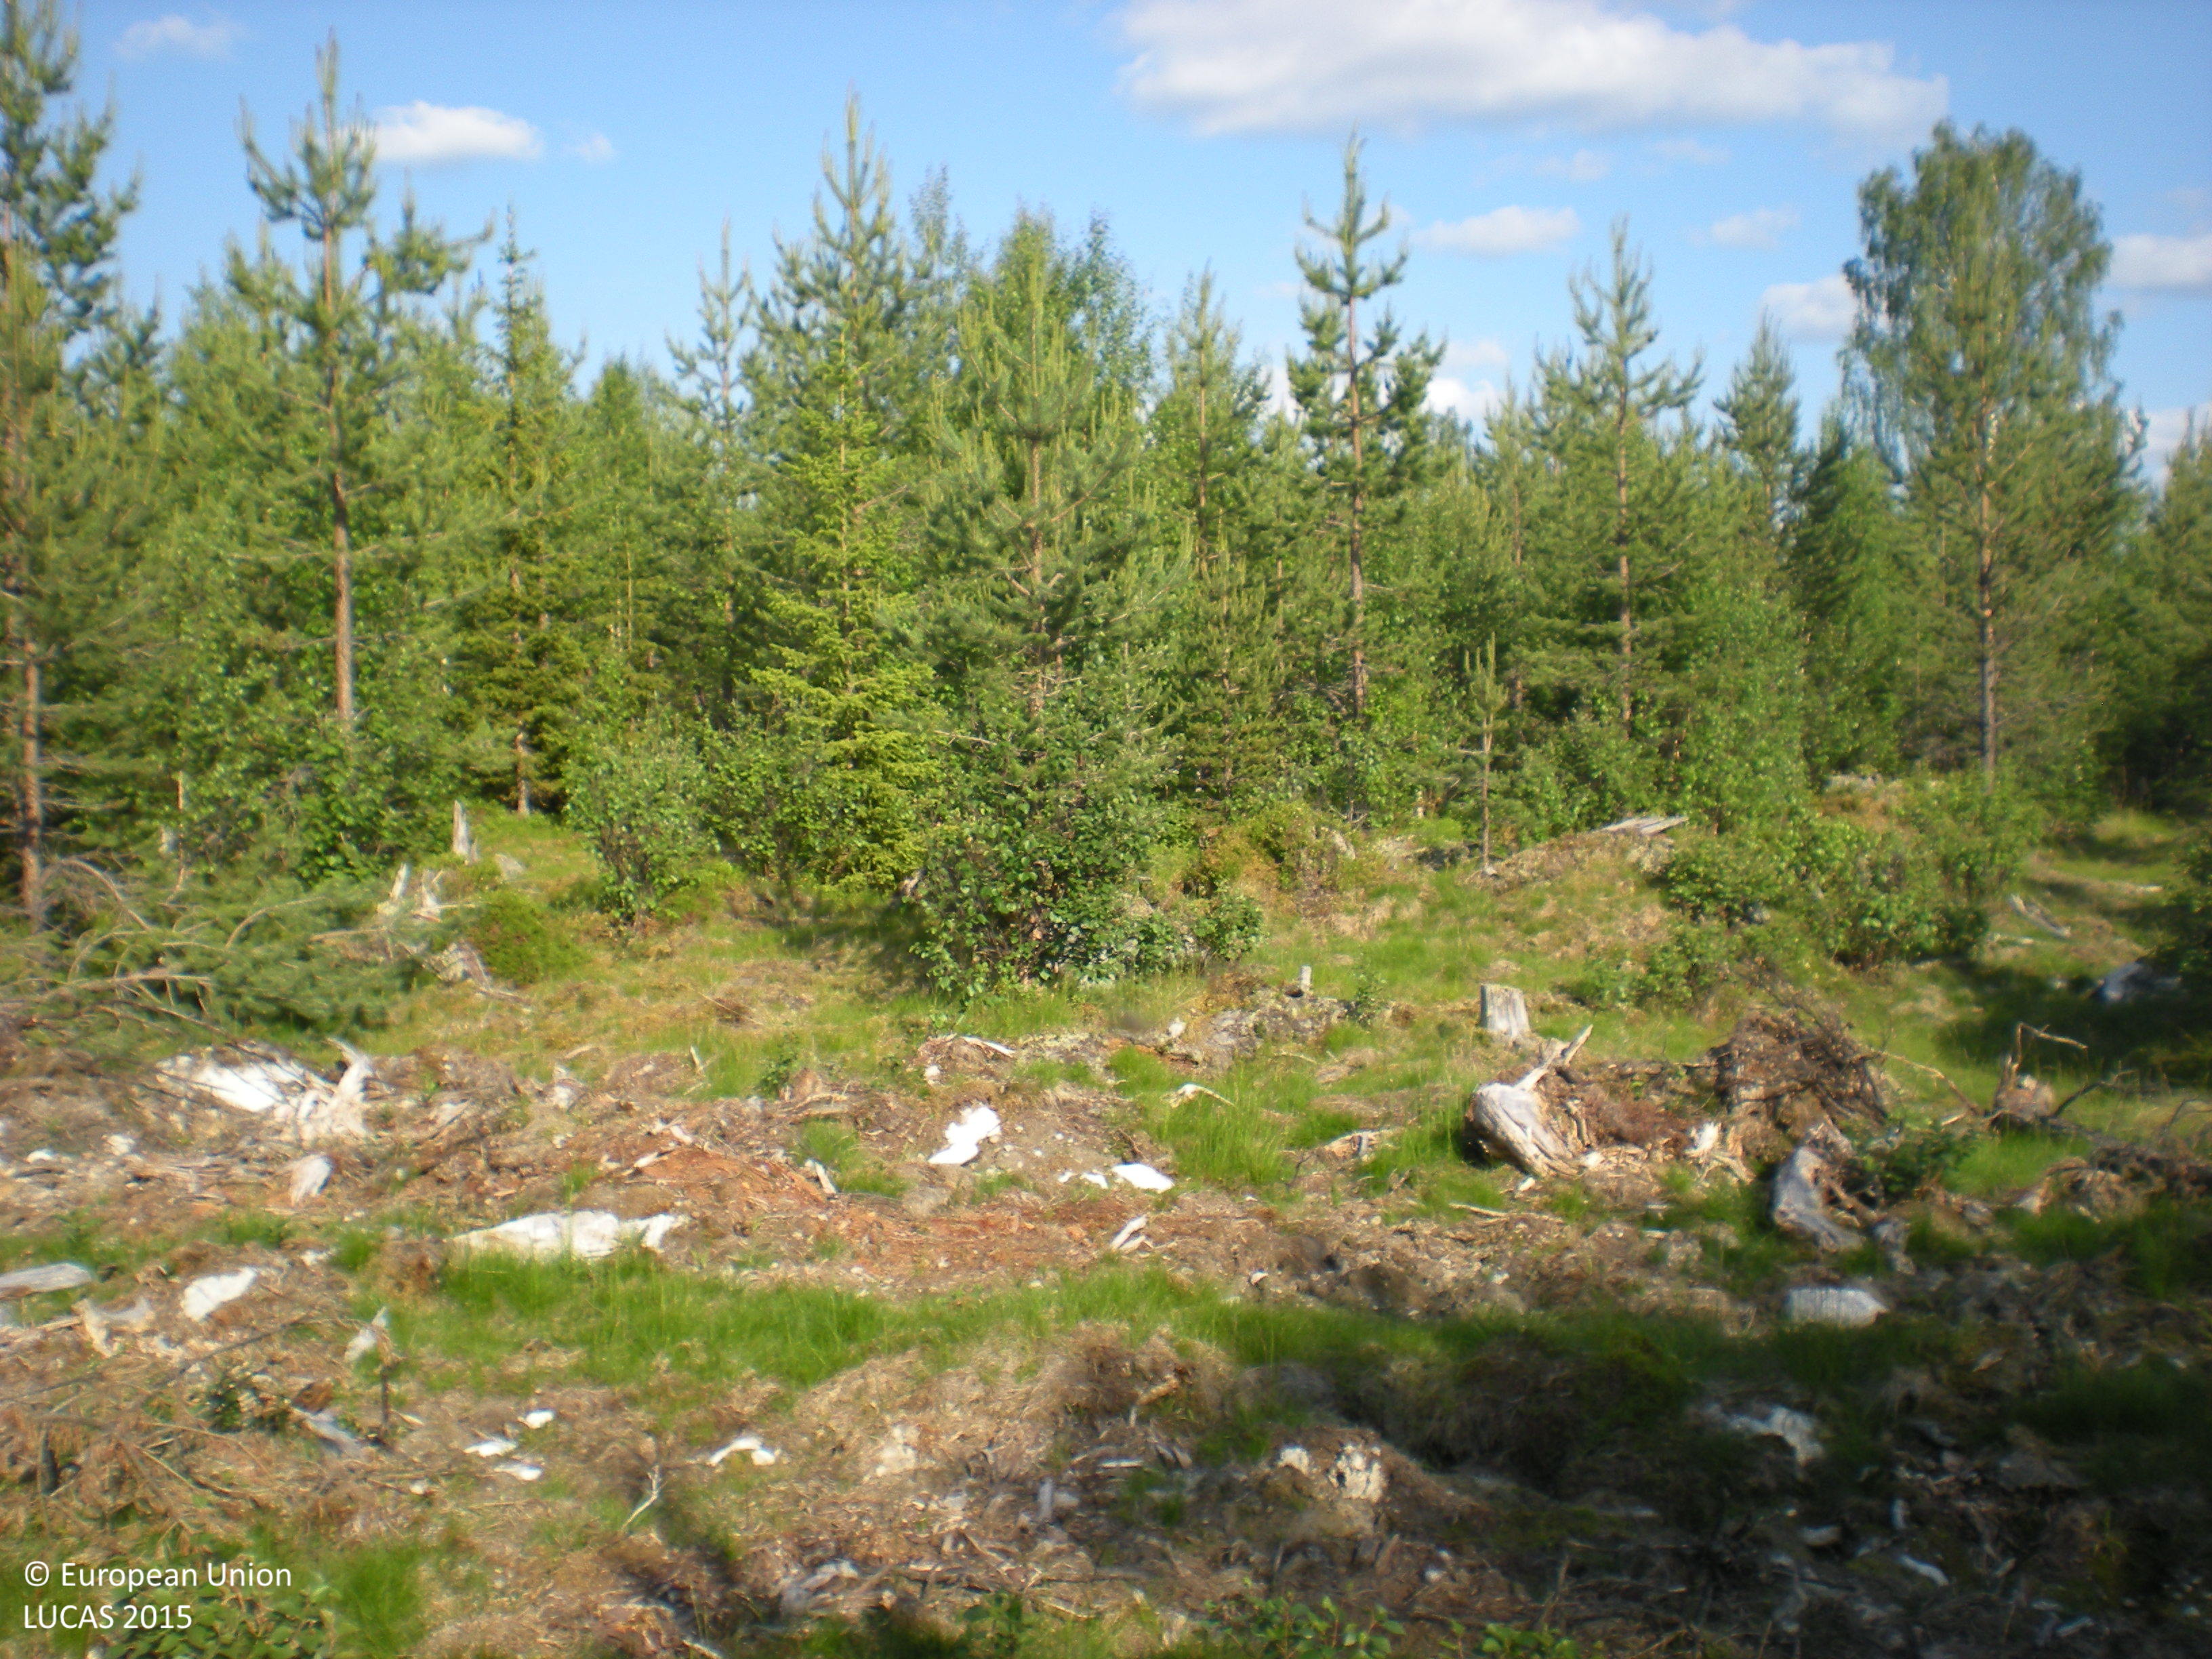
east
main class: Woodland
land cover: Pine dominated mixed woodland
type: boreal forest
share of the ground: 50 - 75 %
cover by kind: coniferous forest trees 30 %, herbaceous plants 30 %, broadleaved forest trees 25 %, shrubs 5 %, lichens and mosses 5 %, consolidated bare surface 5 %
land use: Forestry
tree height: < 5 m
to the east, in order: Pine dominated mixed woodland; Grassland with sparse tree/shrub cover; Pine dominated mixed woodland; Other bare soil; Paved roads, cycling and walking lanes; Pine dominated mixed woodland; Pine dominated coniferous woodland
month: July
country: SE
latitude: 65.4841
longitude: 17.6704
